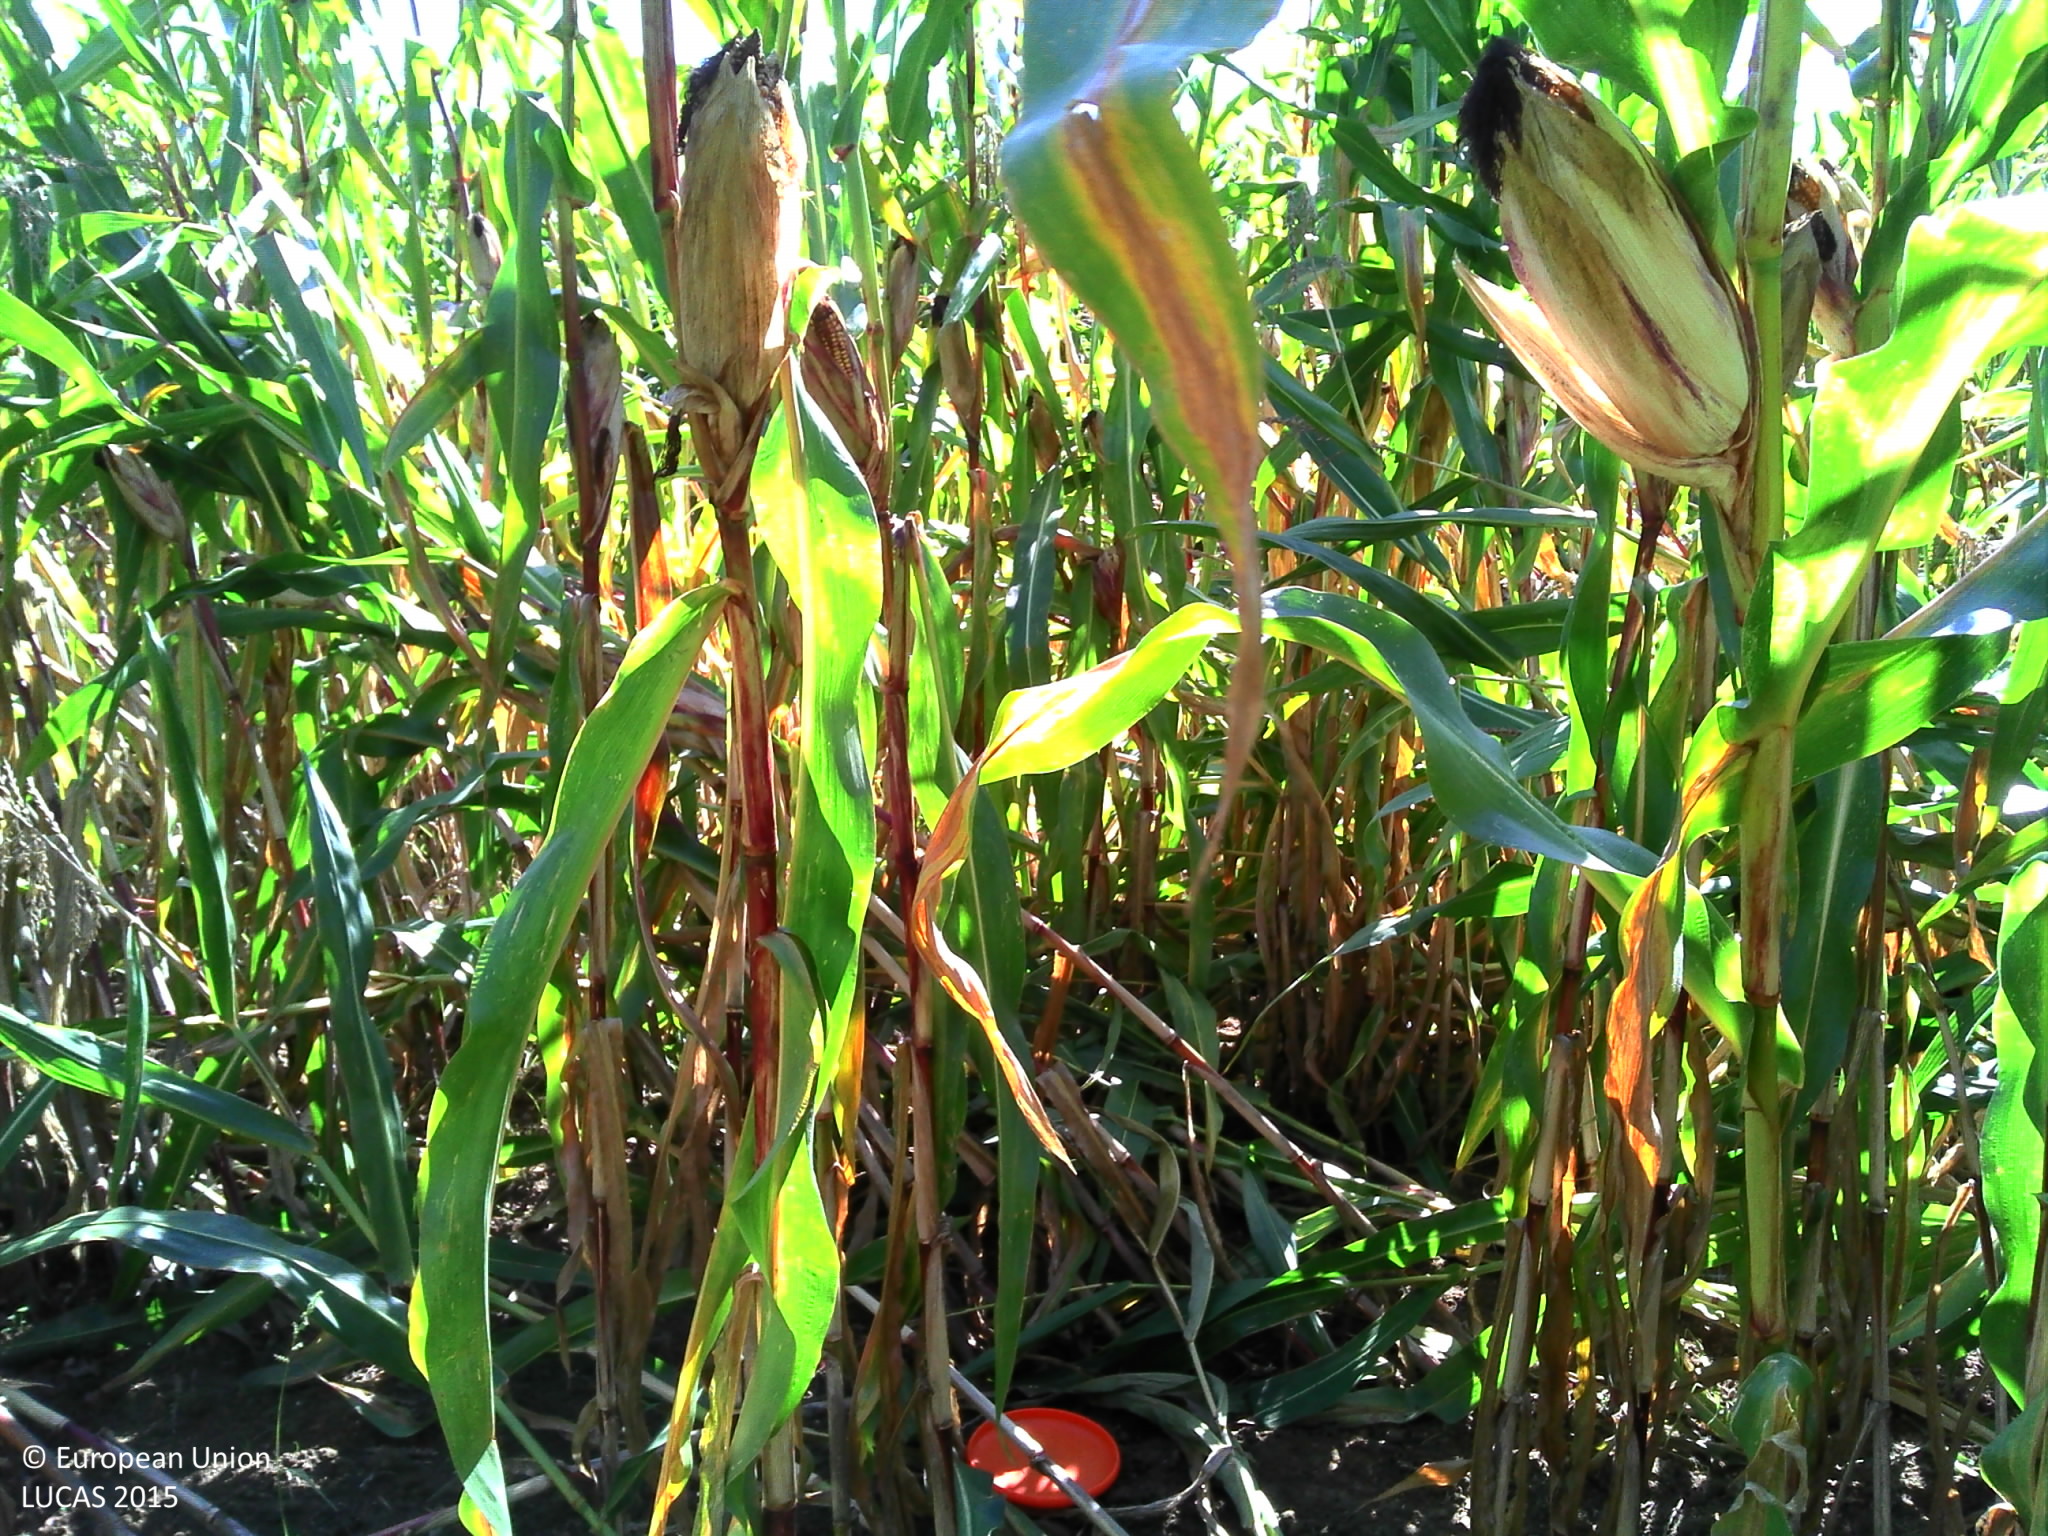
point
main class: Cropland
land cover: Maize
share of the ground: > 75 %
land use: Agriculture (excluding fallow land and kitchen gardens)
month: September
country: FR
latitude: 46.5839
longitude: -1.3246
